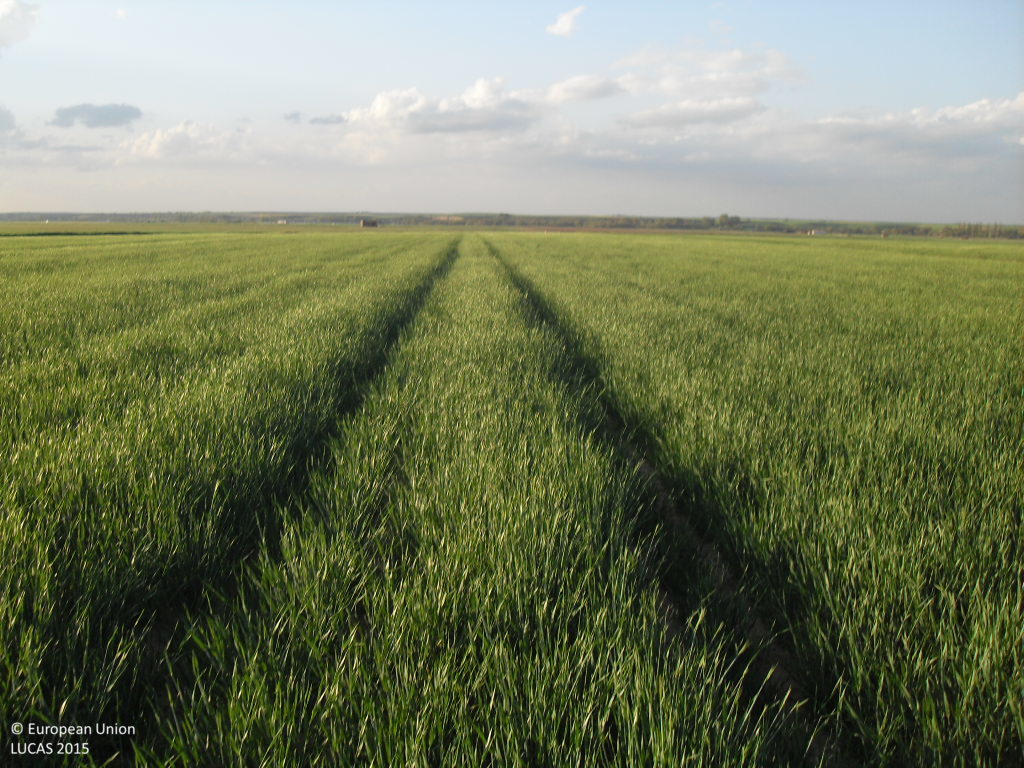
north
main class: Cropland
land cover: Barley
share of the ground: > 75 %
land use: Agriculture (excluding fallow land and kitchen gardens)
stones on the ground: < 10 %
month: May
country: ES
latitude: 40.8648
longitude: -5.2664
